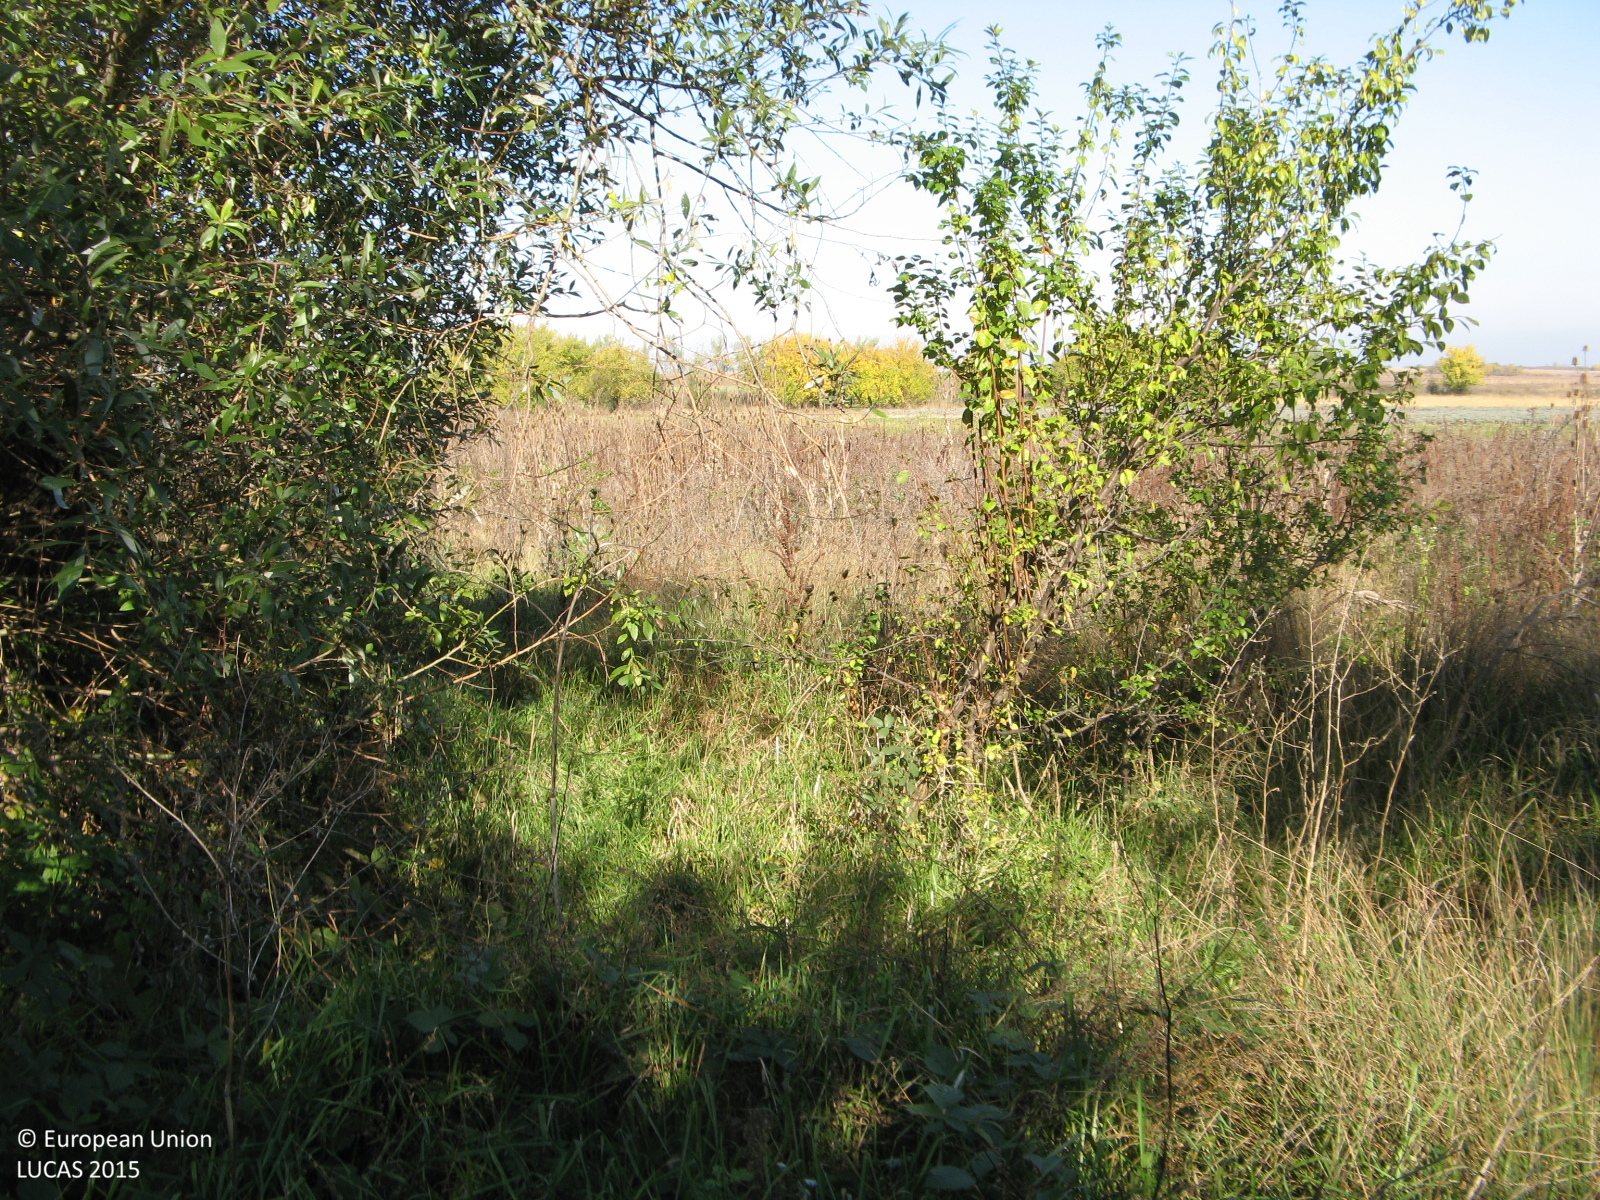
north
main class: Shrubland
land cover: Shrubland with sparse tree cover
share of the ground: > 75 %
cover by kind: shrubs 85 %, herbaceous plants 10 %, broadleaved forest trees 5 %
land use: Semi-natural and natural areas not in use
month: November
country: BG
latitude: 41.9796
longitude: 25.0568
